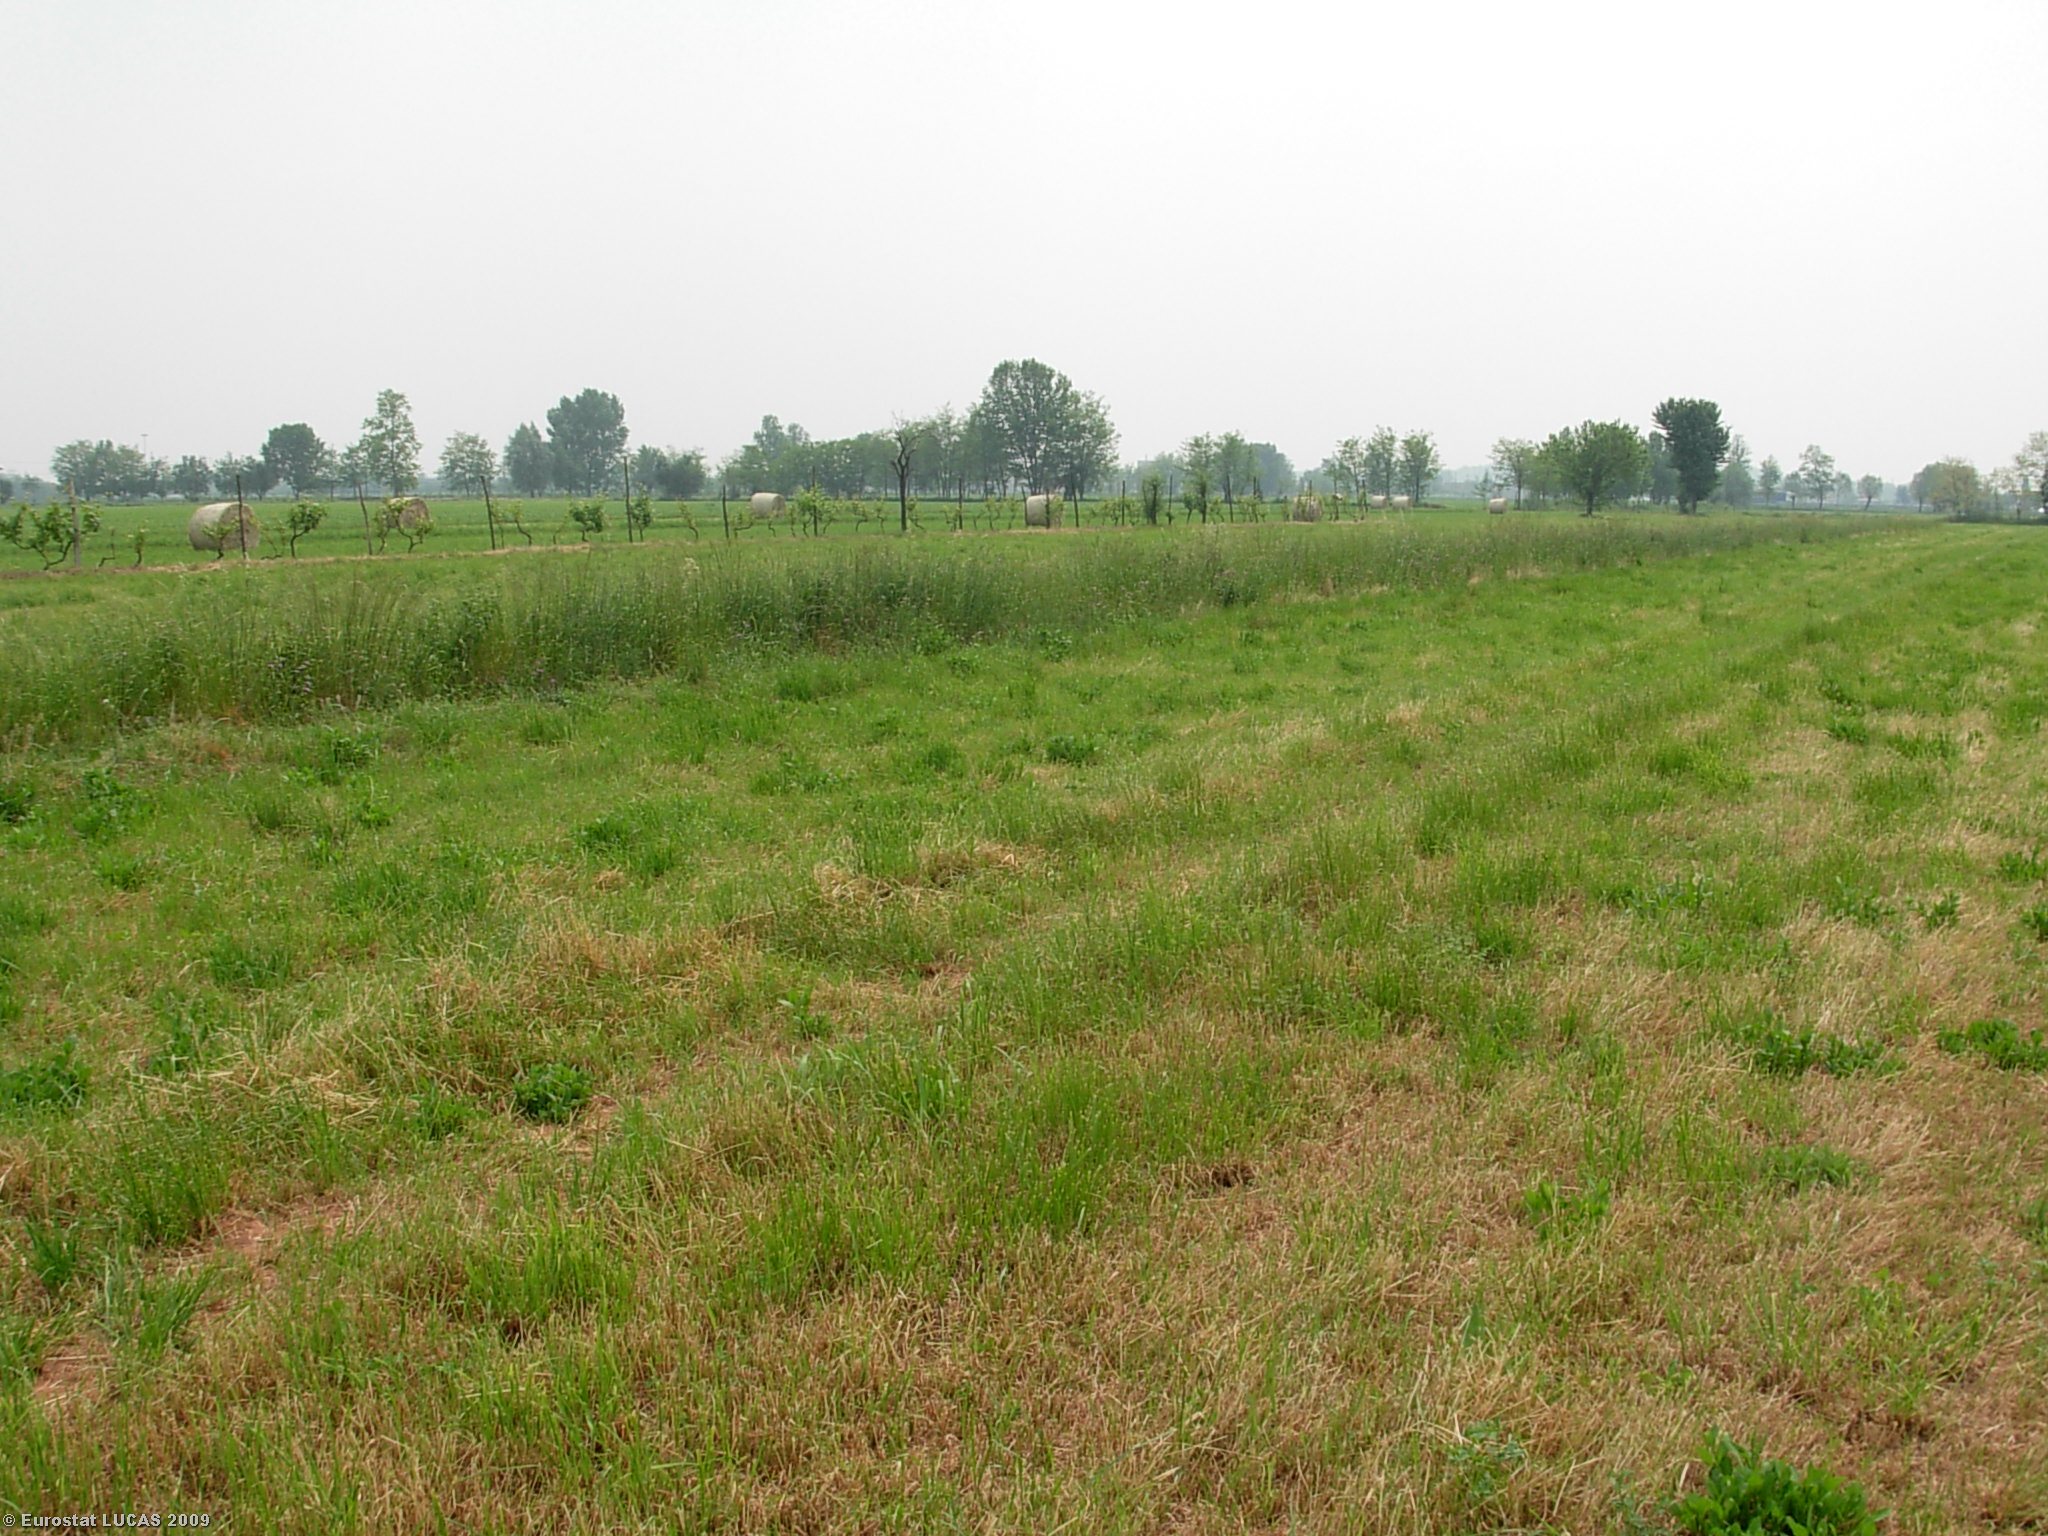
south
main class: Grassland
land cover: Grassland without tree/shrub cover
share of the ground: > 75 %
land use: Agriculture (excluding fallow land and kitchen gardens)
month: May
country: IT
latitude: 45.3953
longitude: 10.4463
